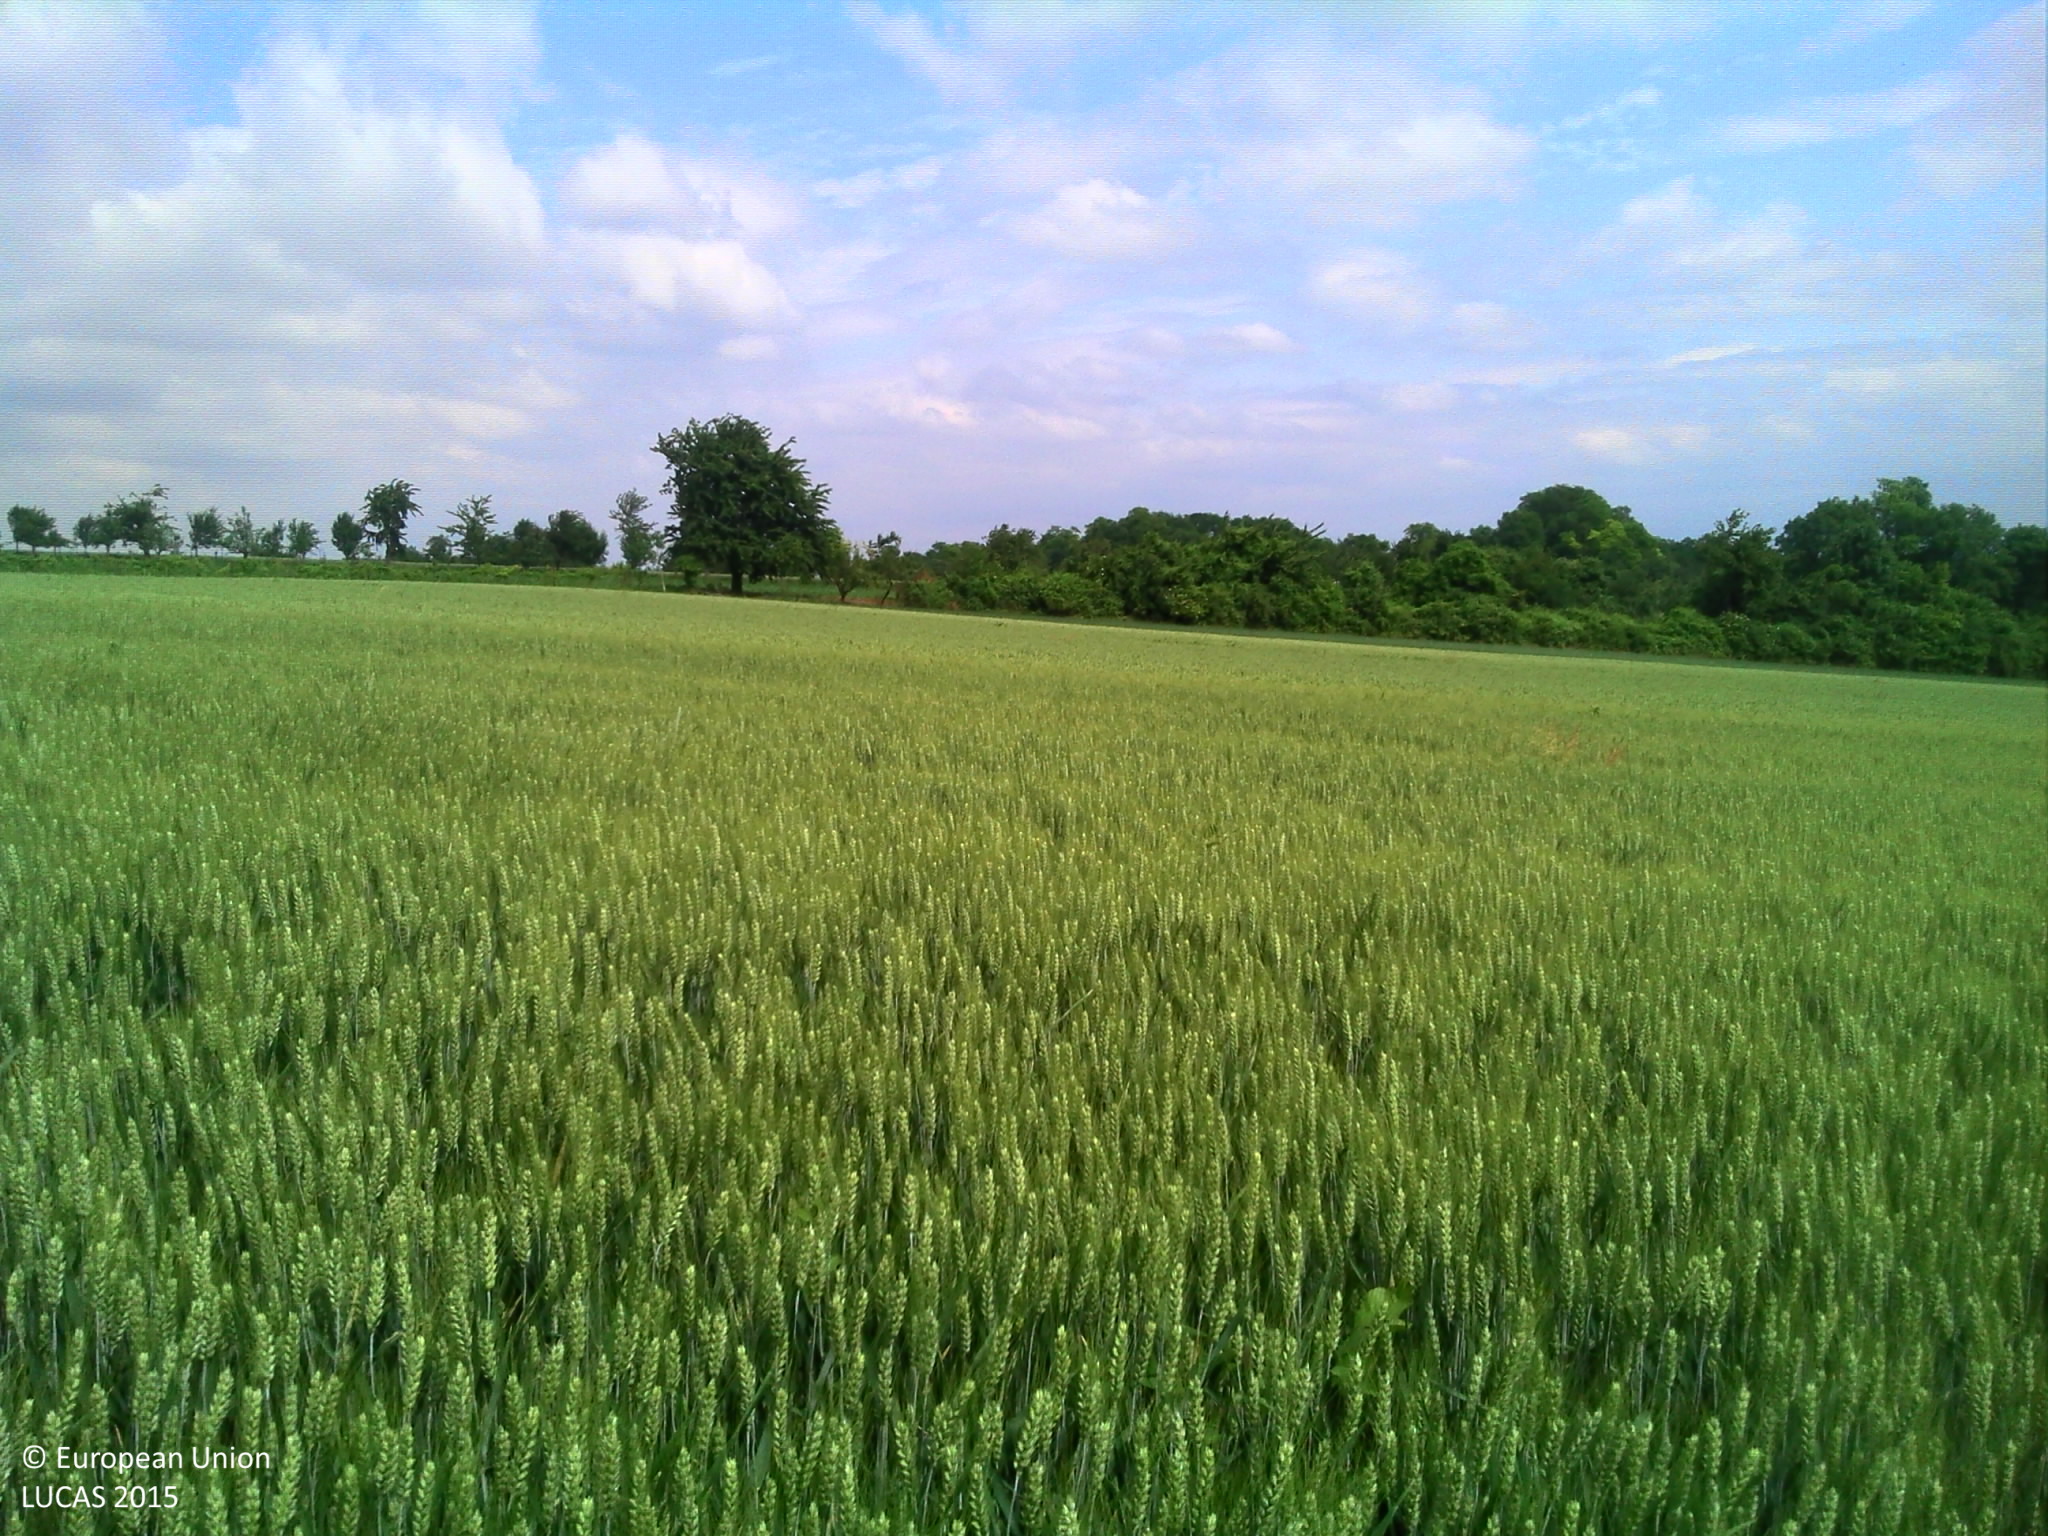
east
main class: Cropland
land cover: Common wheat
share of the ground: > 75 %
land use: Agriculture (excluding fallow land and kitchen gardens)
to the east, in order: Common wheat; Other fresh vegetables; Grass margins; Vineyards; Grass margins; Maize; Grass margins; Cherry fruit; Apple fruit; Grass margins; Common wheat; Grass margins; Tracks; Grass margins; Maize
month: June
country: FR
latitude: 48.5575
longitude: 7.6026
